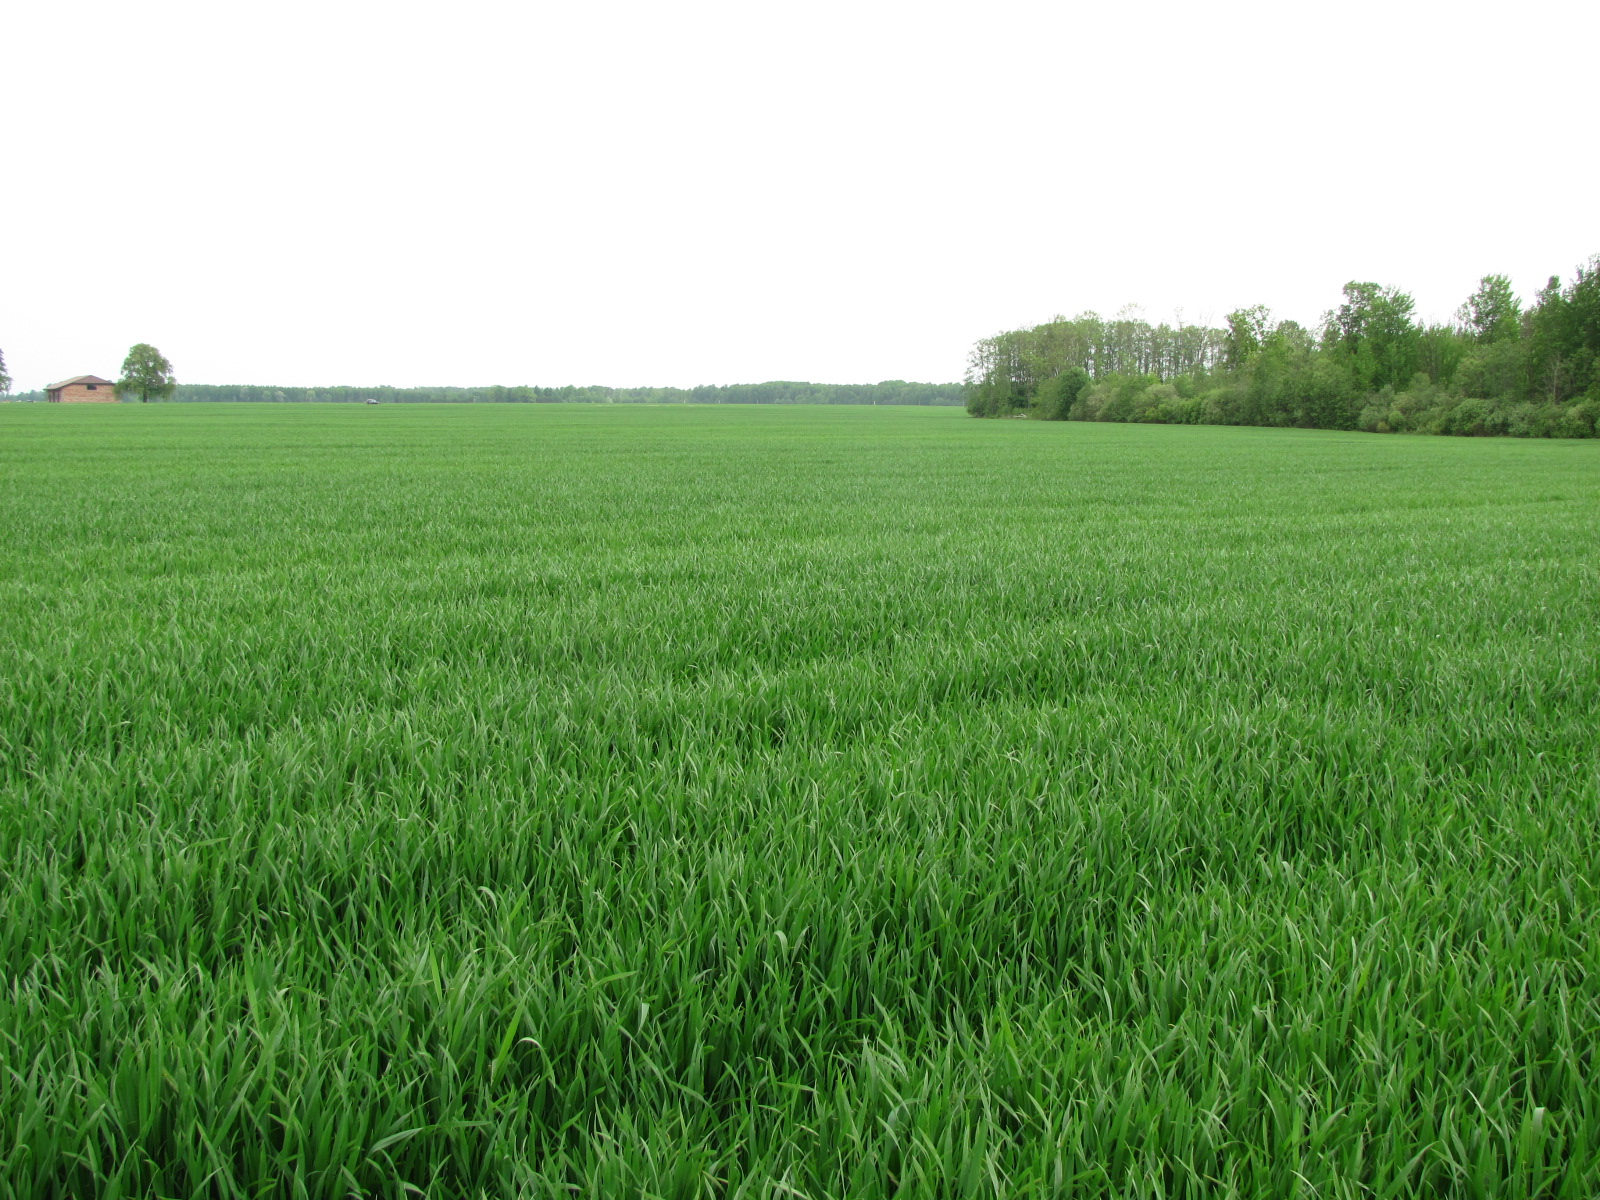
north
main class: Cropland
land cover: Common wheat
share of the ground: > 75 %
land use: Agriculture (excluding fallow land and kitchen gardens)
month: May
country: LV
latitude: 56.4651
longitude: 24.0941
